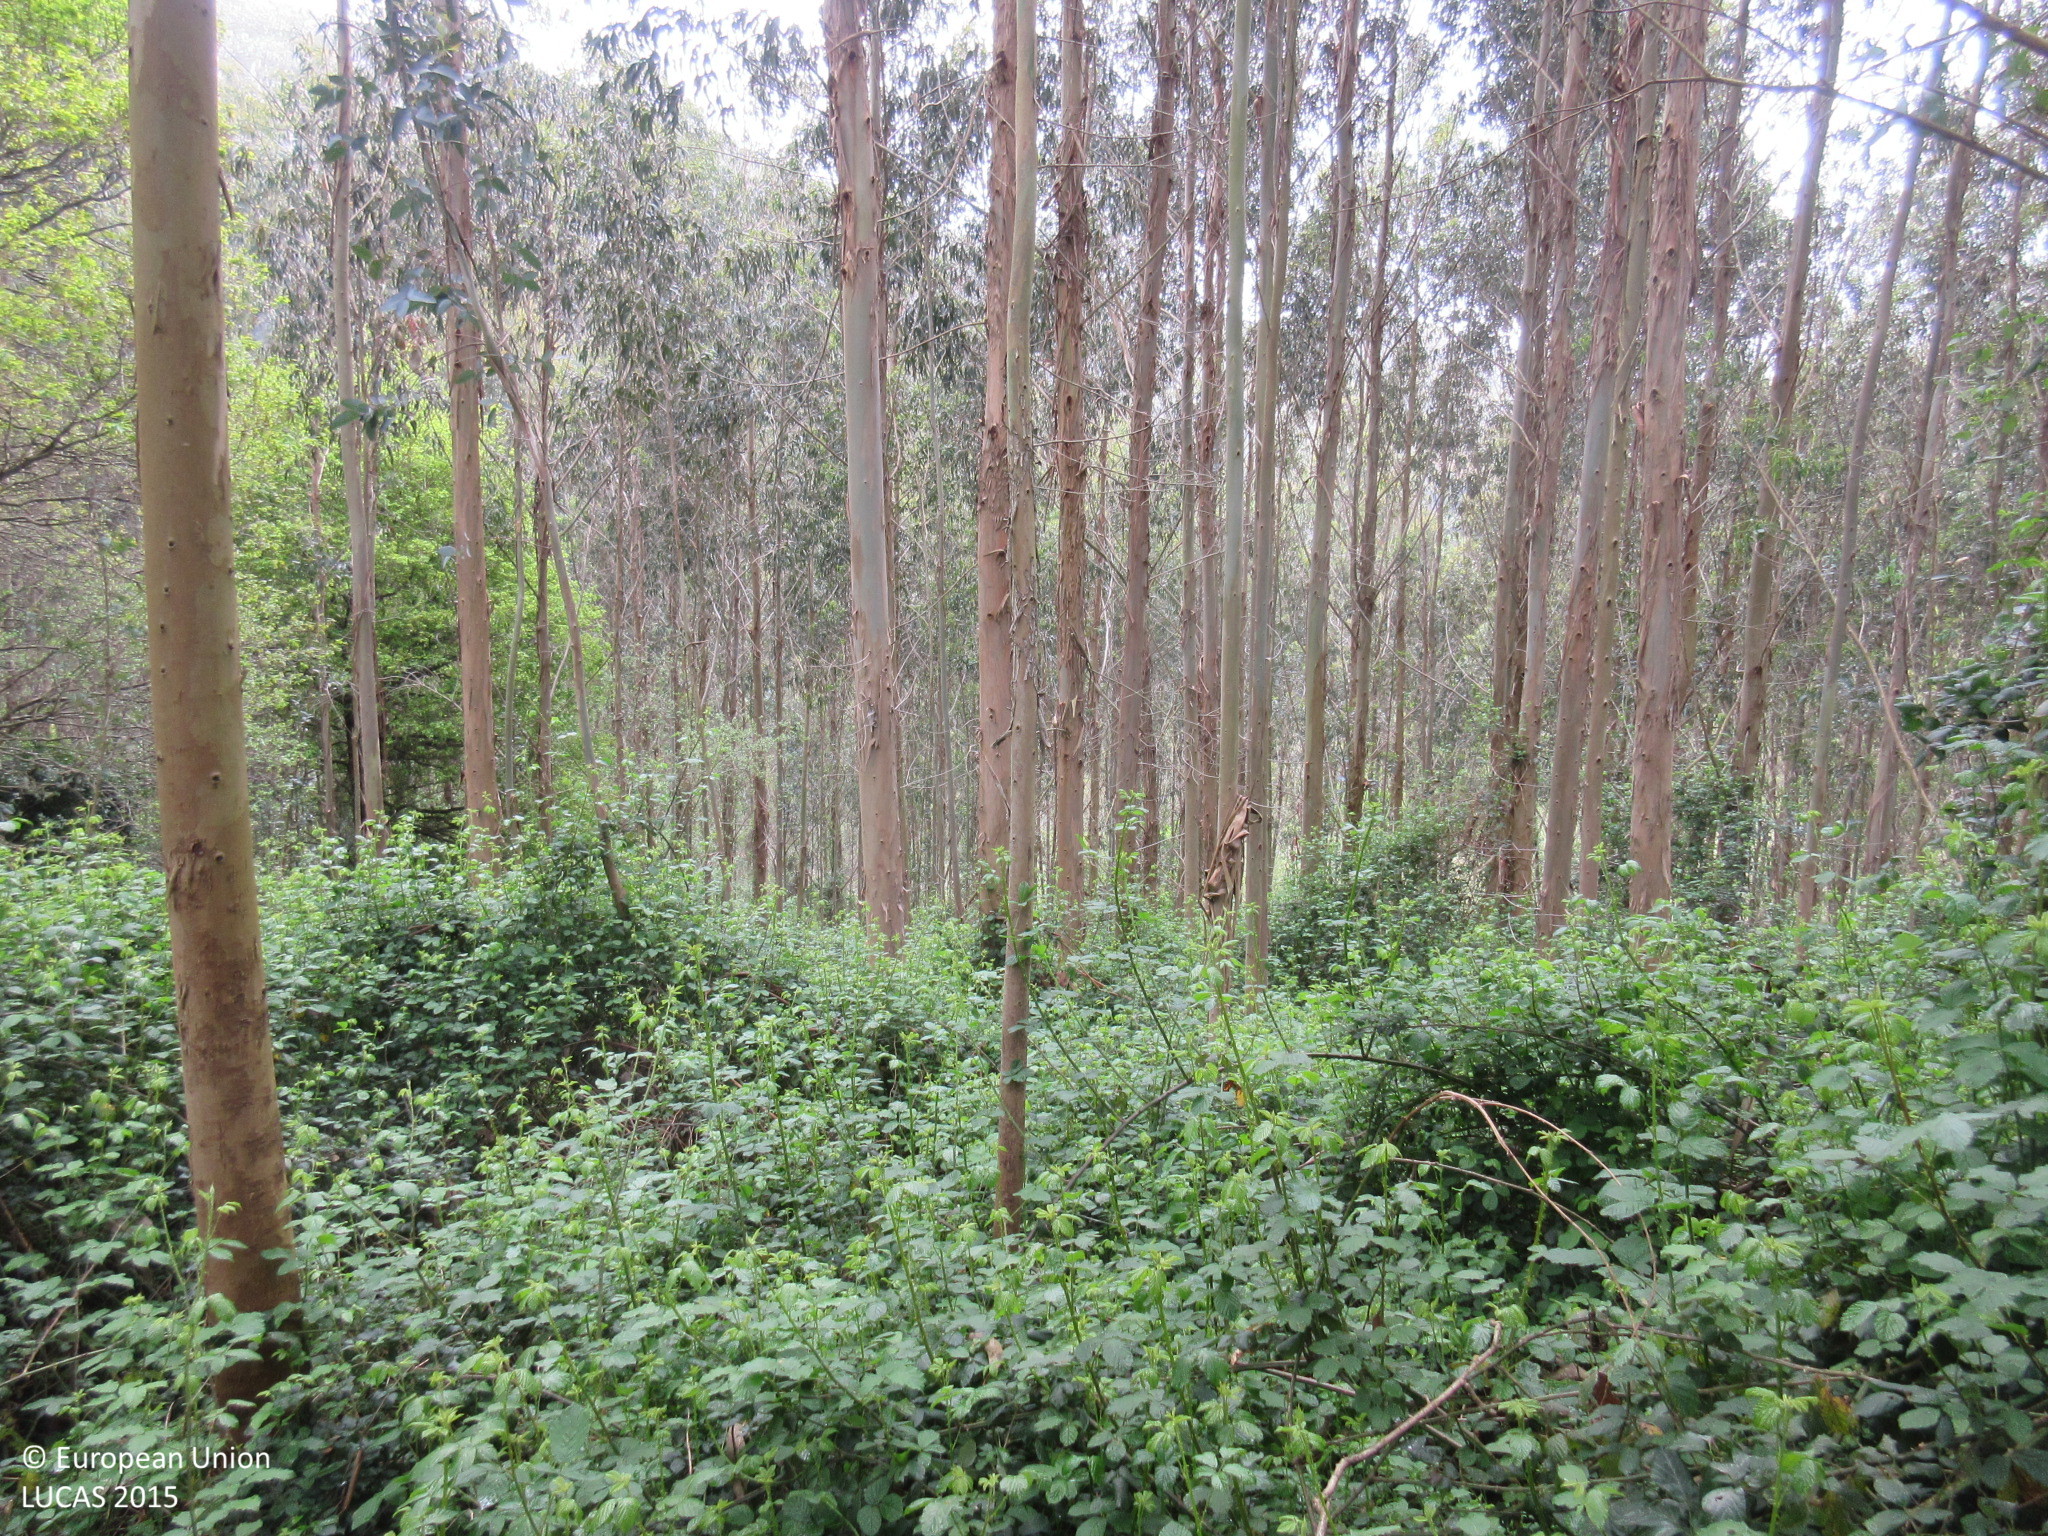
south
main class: Woodland
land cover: Broadleaved woodland
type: exotic forest
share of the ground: > 75 %
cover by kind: broadleaved forest trees 90 %, shrubs 10 %
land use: Forestry
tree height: > 5 m
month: April
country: ES
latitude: 43.4523
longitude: -5.1376
